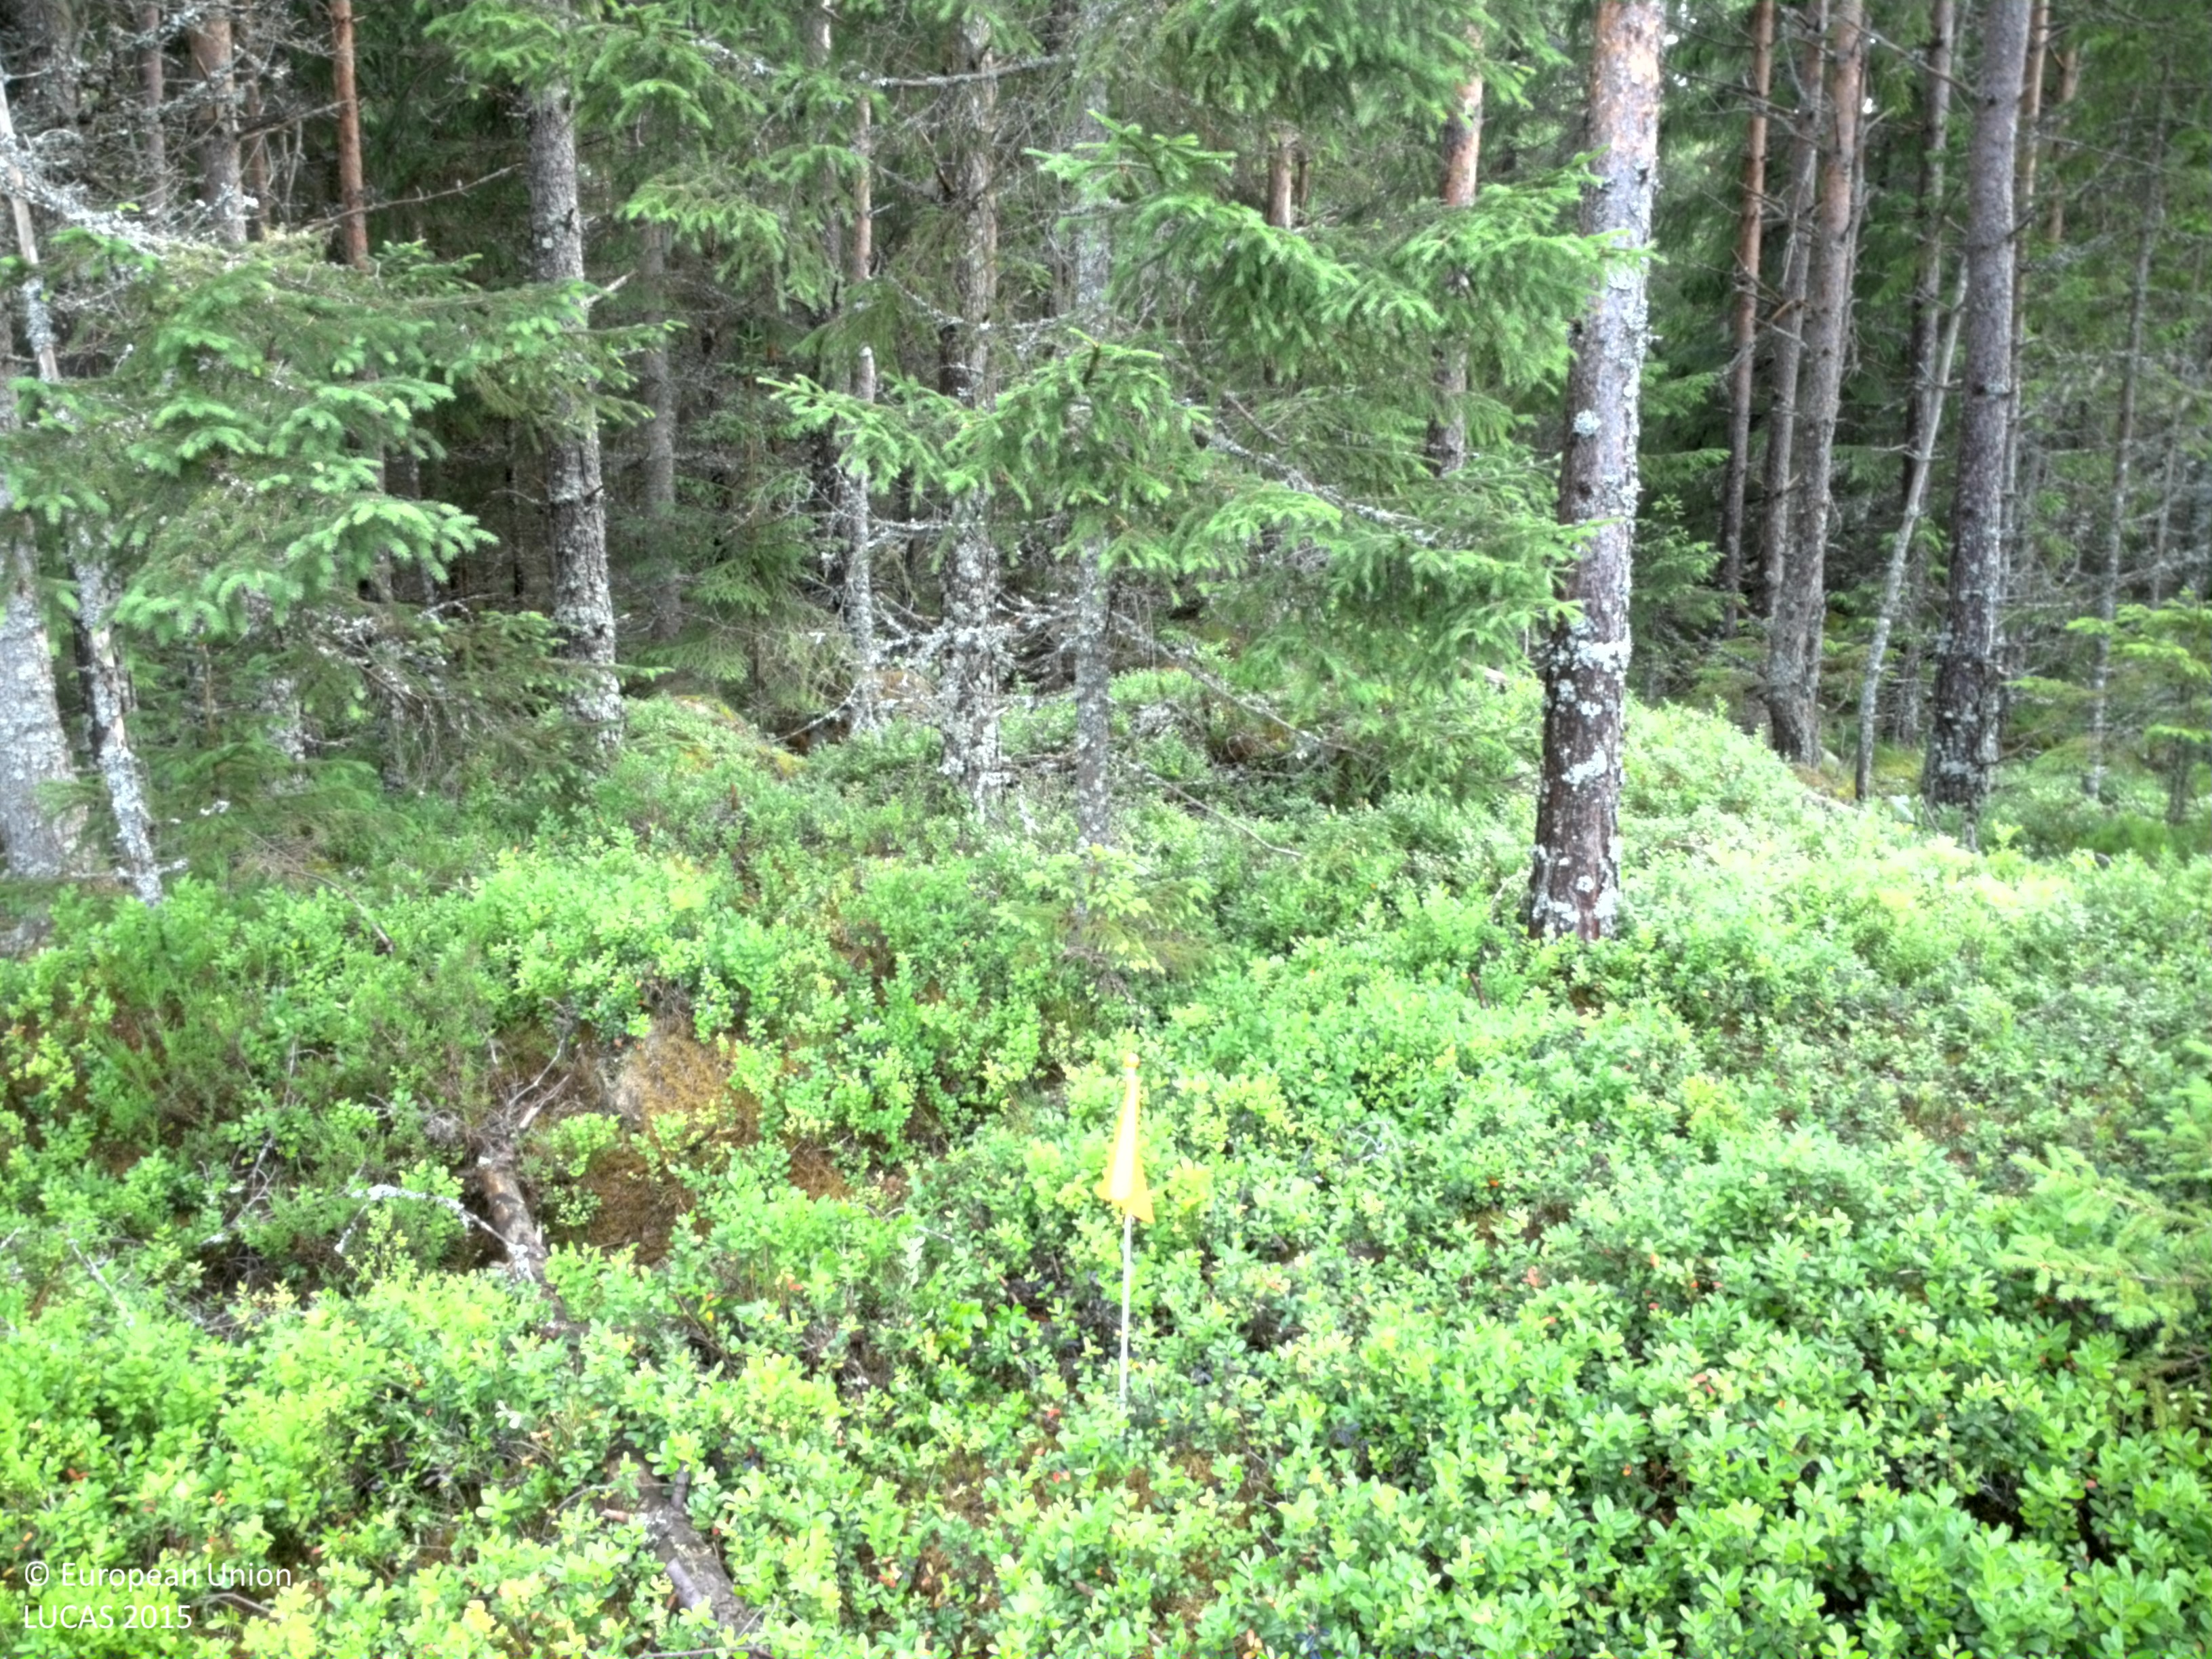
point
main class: Woodland
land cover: Pine dominated coniferous woodland
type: boreal forest
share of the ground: > 75 %
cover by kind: coniferous forest trees 70 %, shrubs 20 %, broadleaved forest trees 10 %
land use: Forestry
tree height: > 5 m
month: July
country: SE
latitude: 59.4544
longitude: 14.6658
